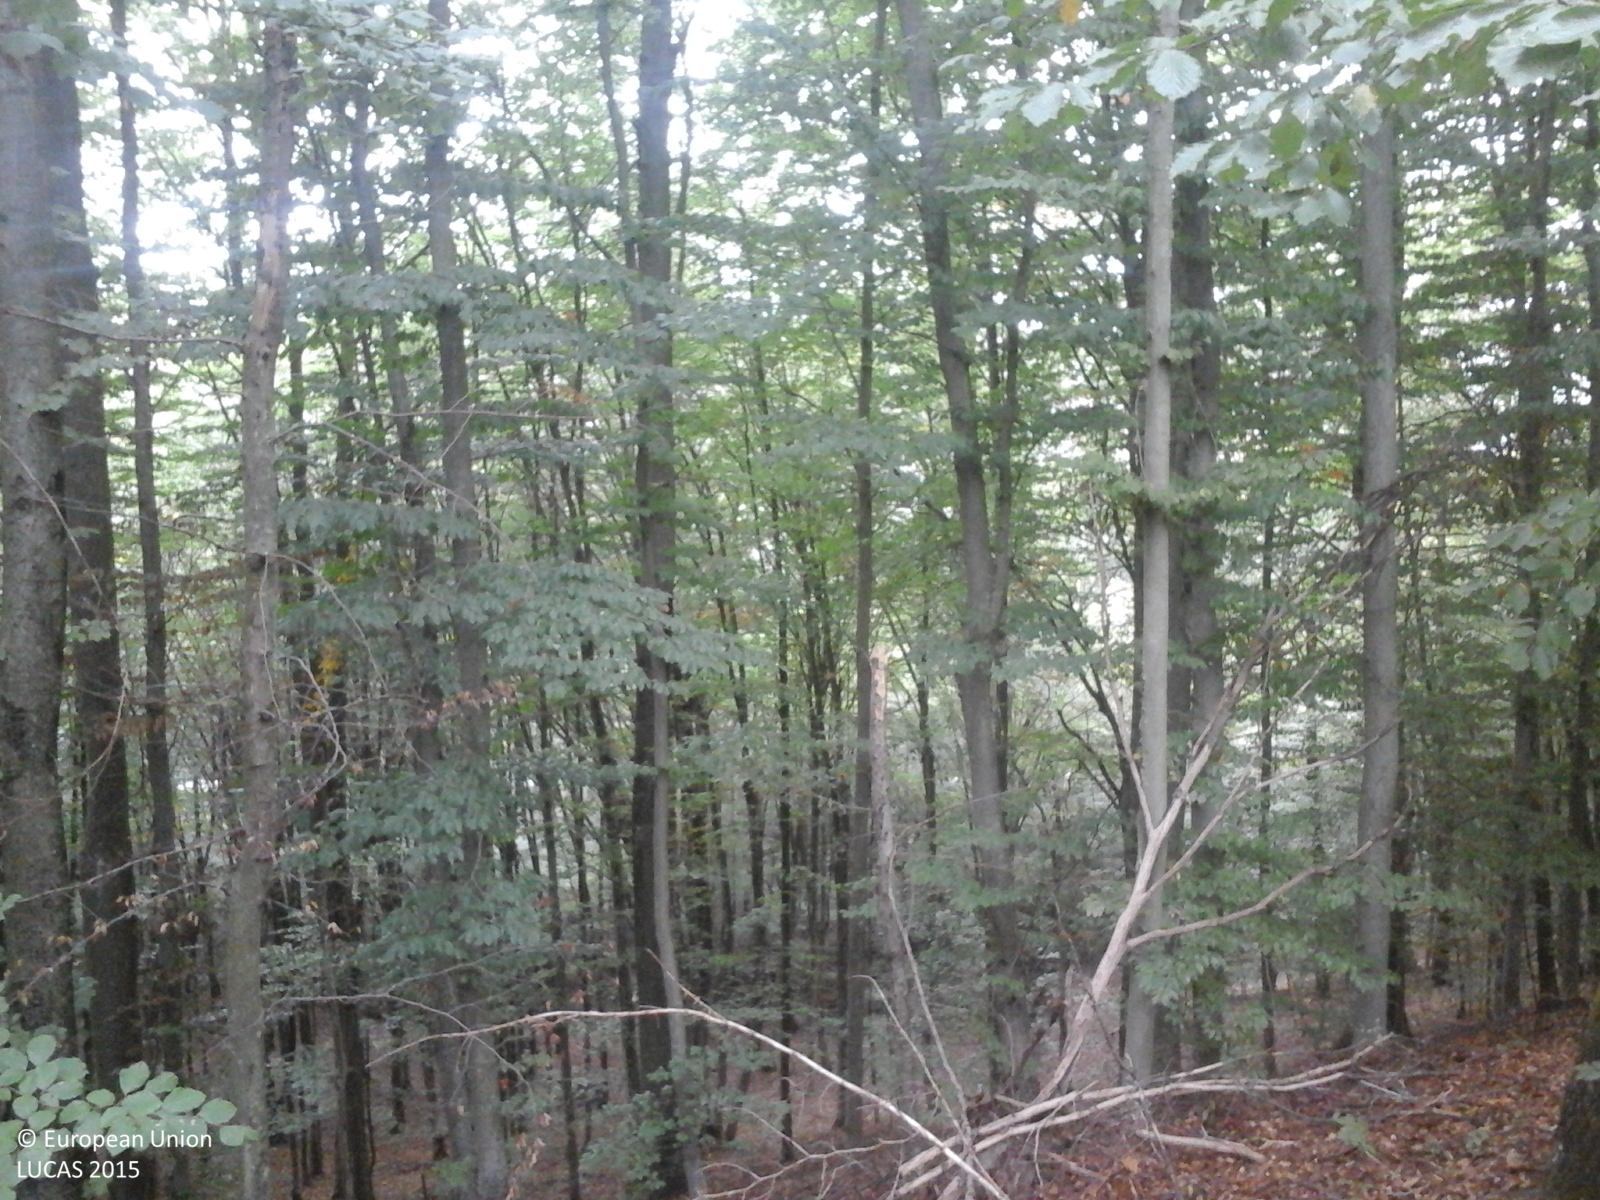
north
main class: Woodland
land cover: Broadleaved woodland
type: beech forest
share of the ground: > 75 %
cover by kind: broadleaved forest trees 100 %
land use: Forestry
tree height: > 5 m
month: September
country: RO
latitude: 45.7748
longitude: 22.2219
